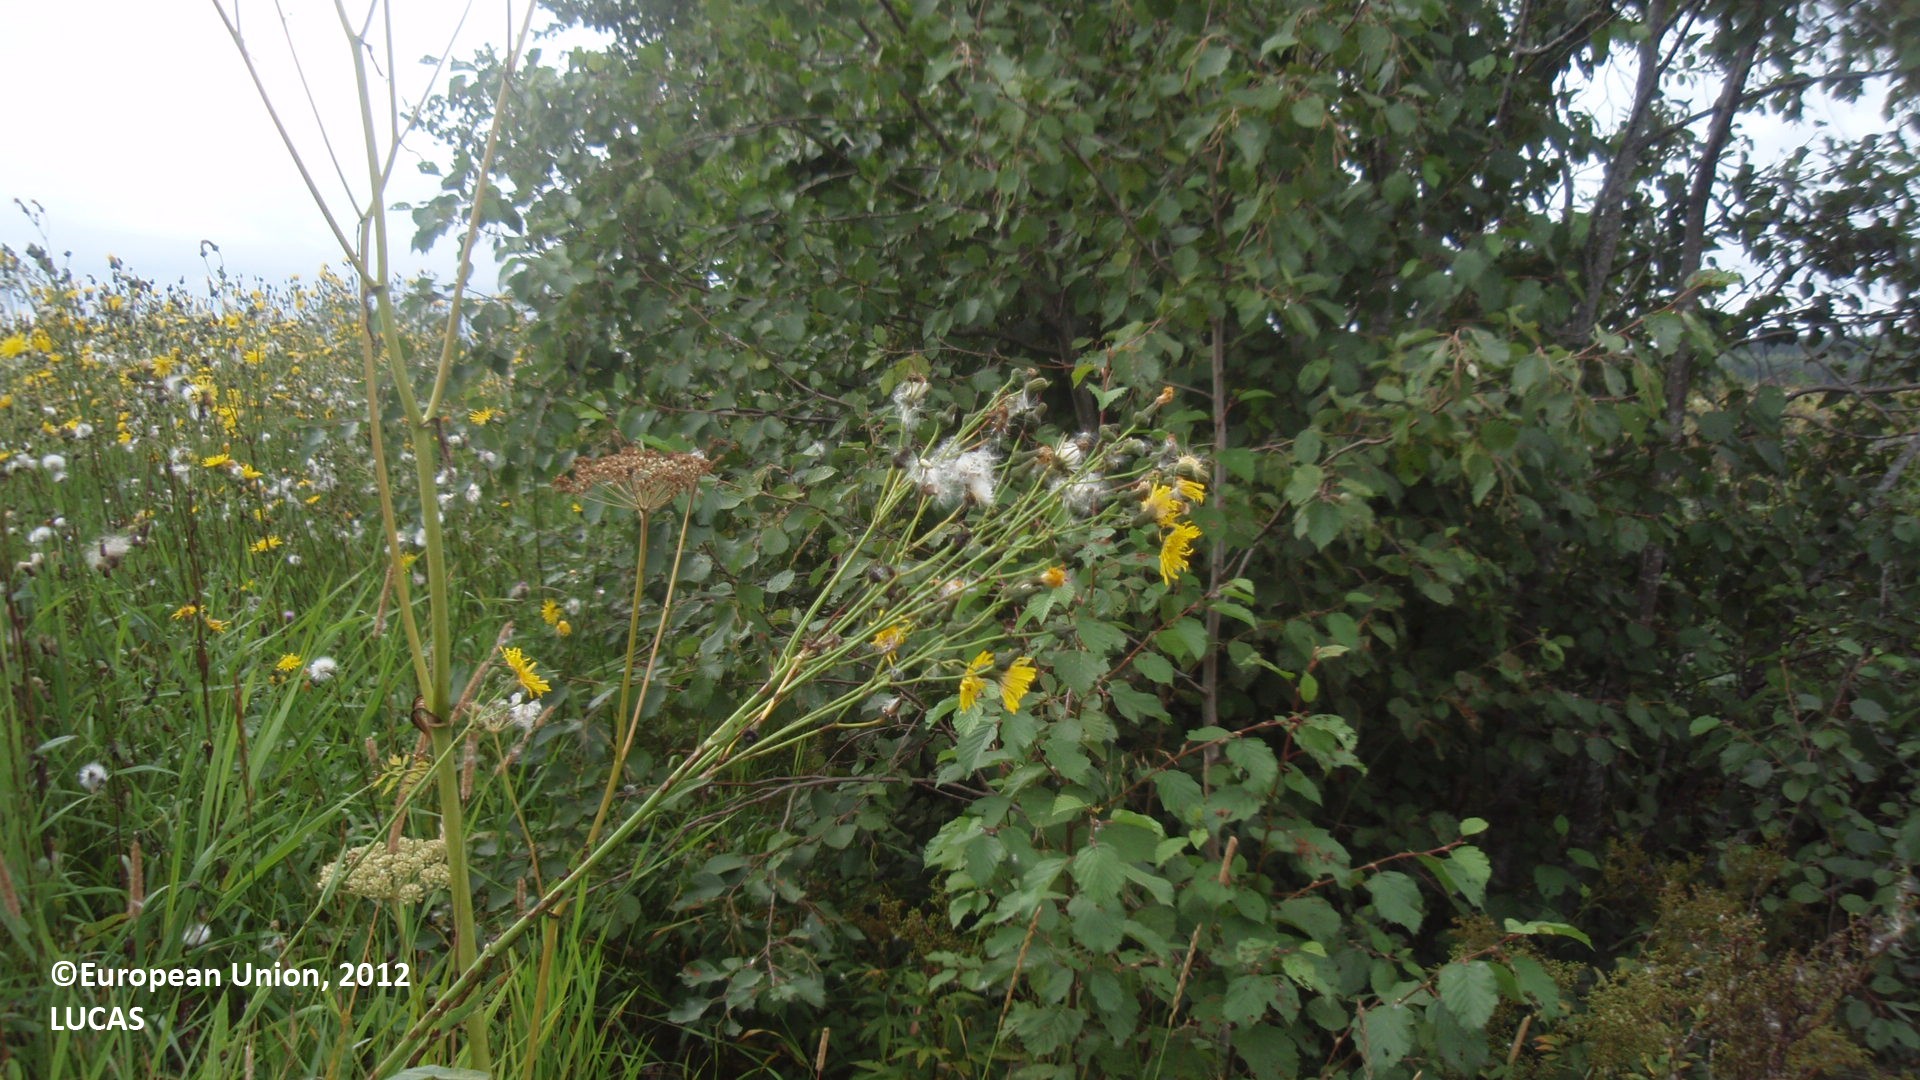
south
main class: Cropland
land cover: Mixed cereals for fodder
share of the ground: > 75 %
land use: Agriculture (excluding fallow land and kitchen gardens)
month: August
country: FI
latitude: 61.0411
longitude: 26.6907
